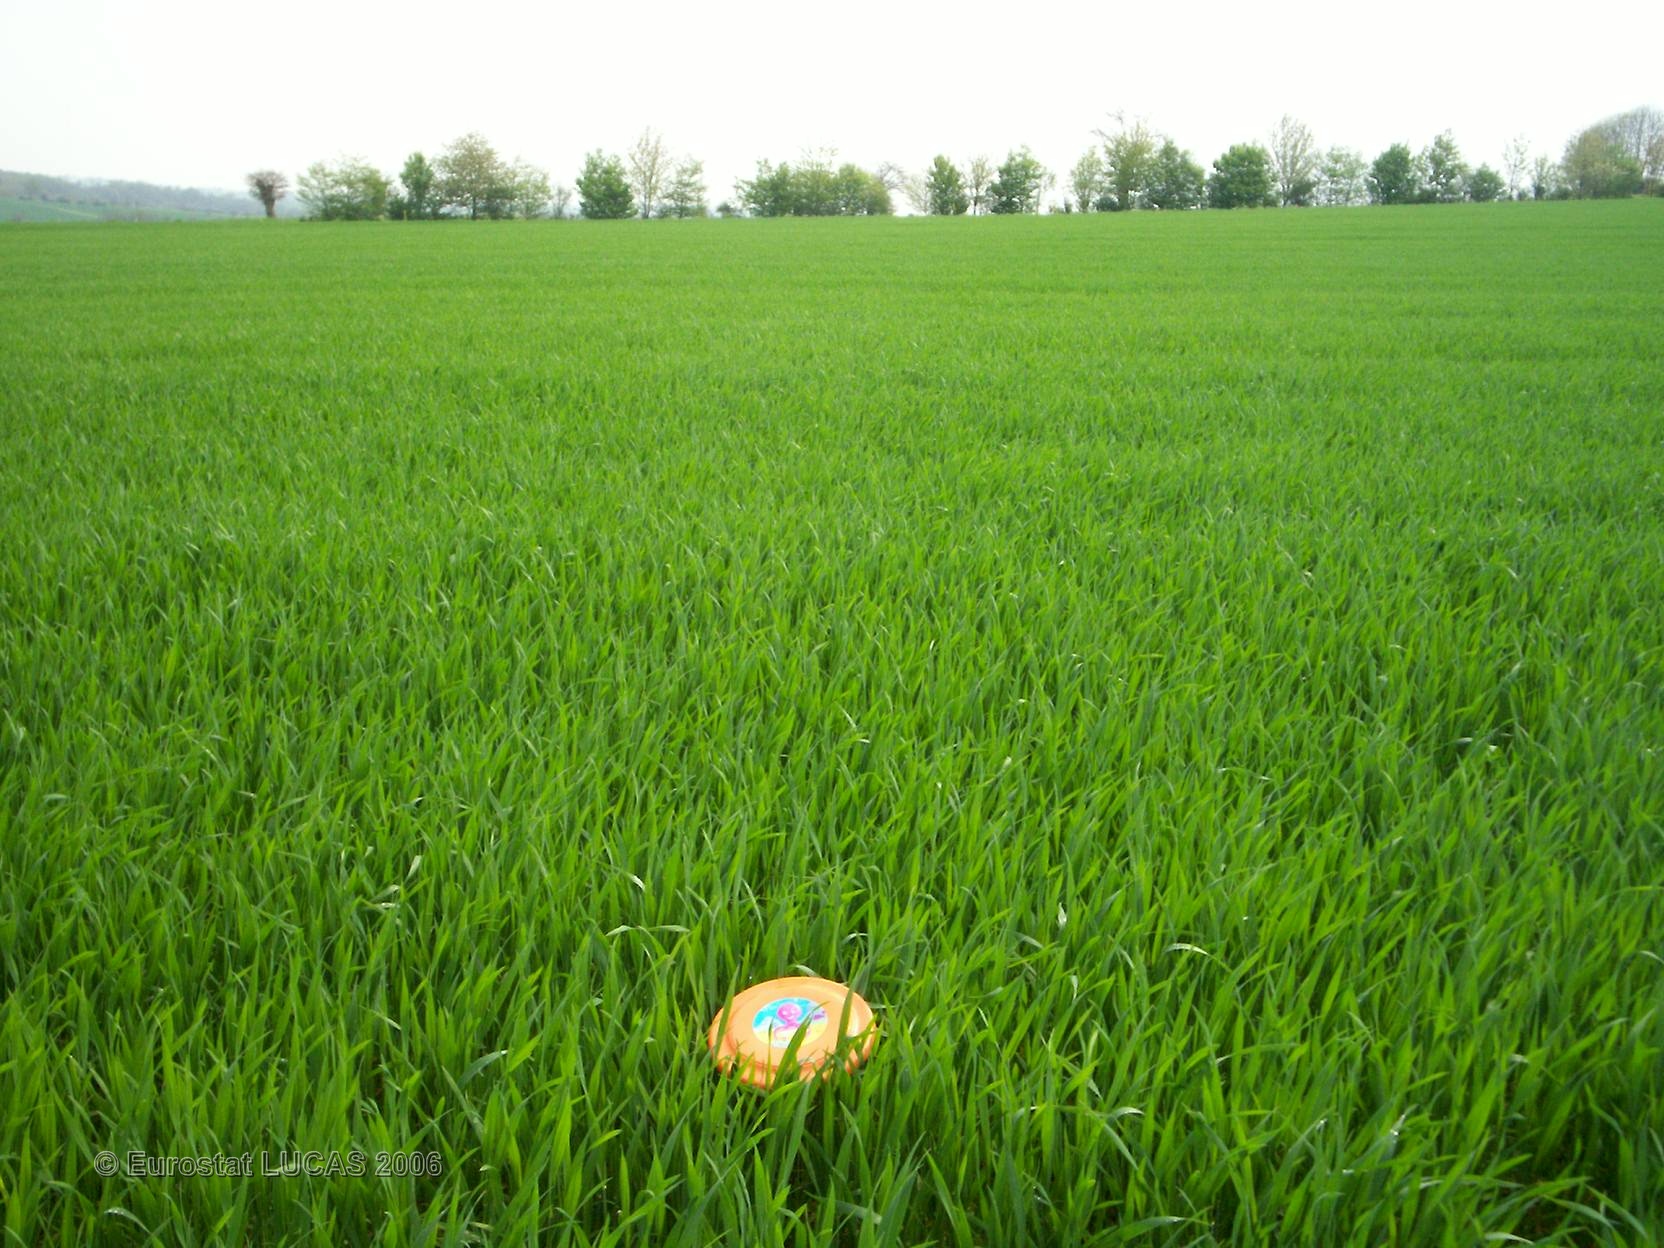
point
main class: Cropland
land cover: Common wheat
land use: Agriculture (excluding fallow land and kitchen gardens)
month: April
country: FR
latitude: 47.8326
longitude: -1.5476
